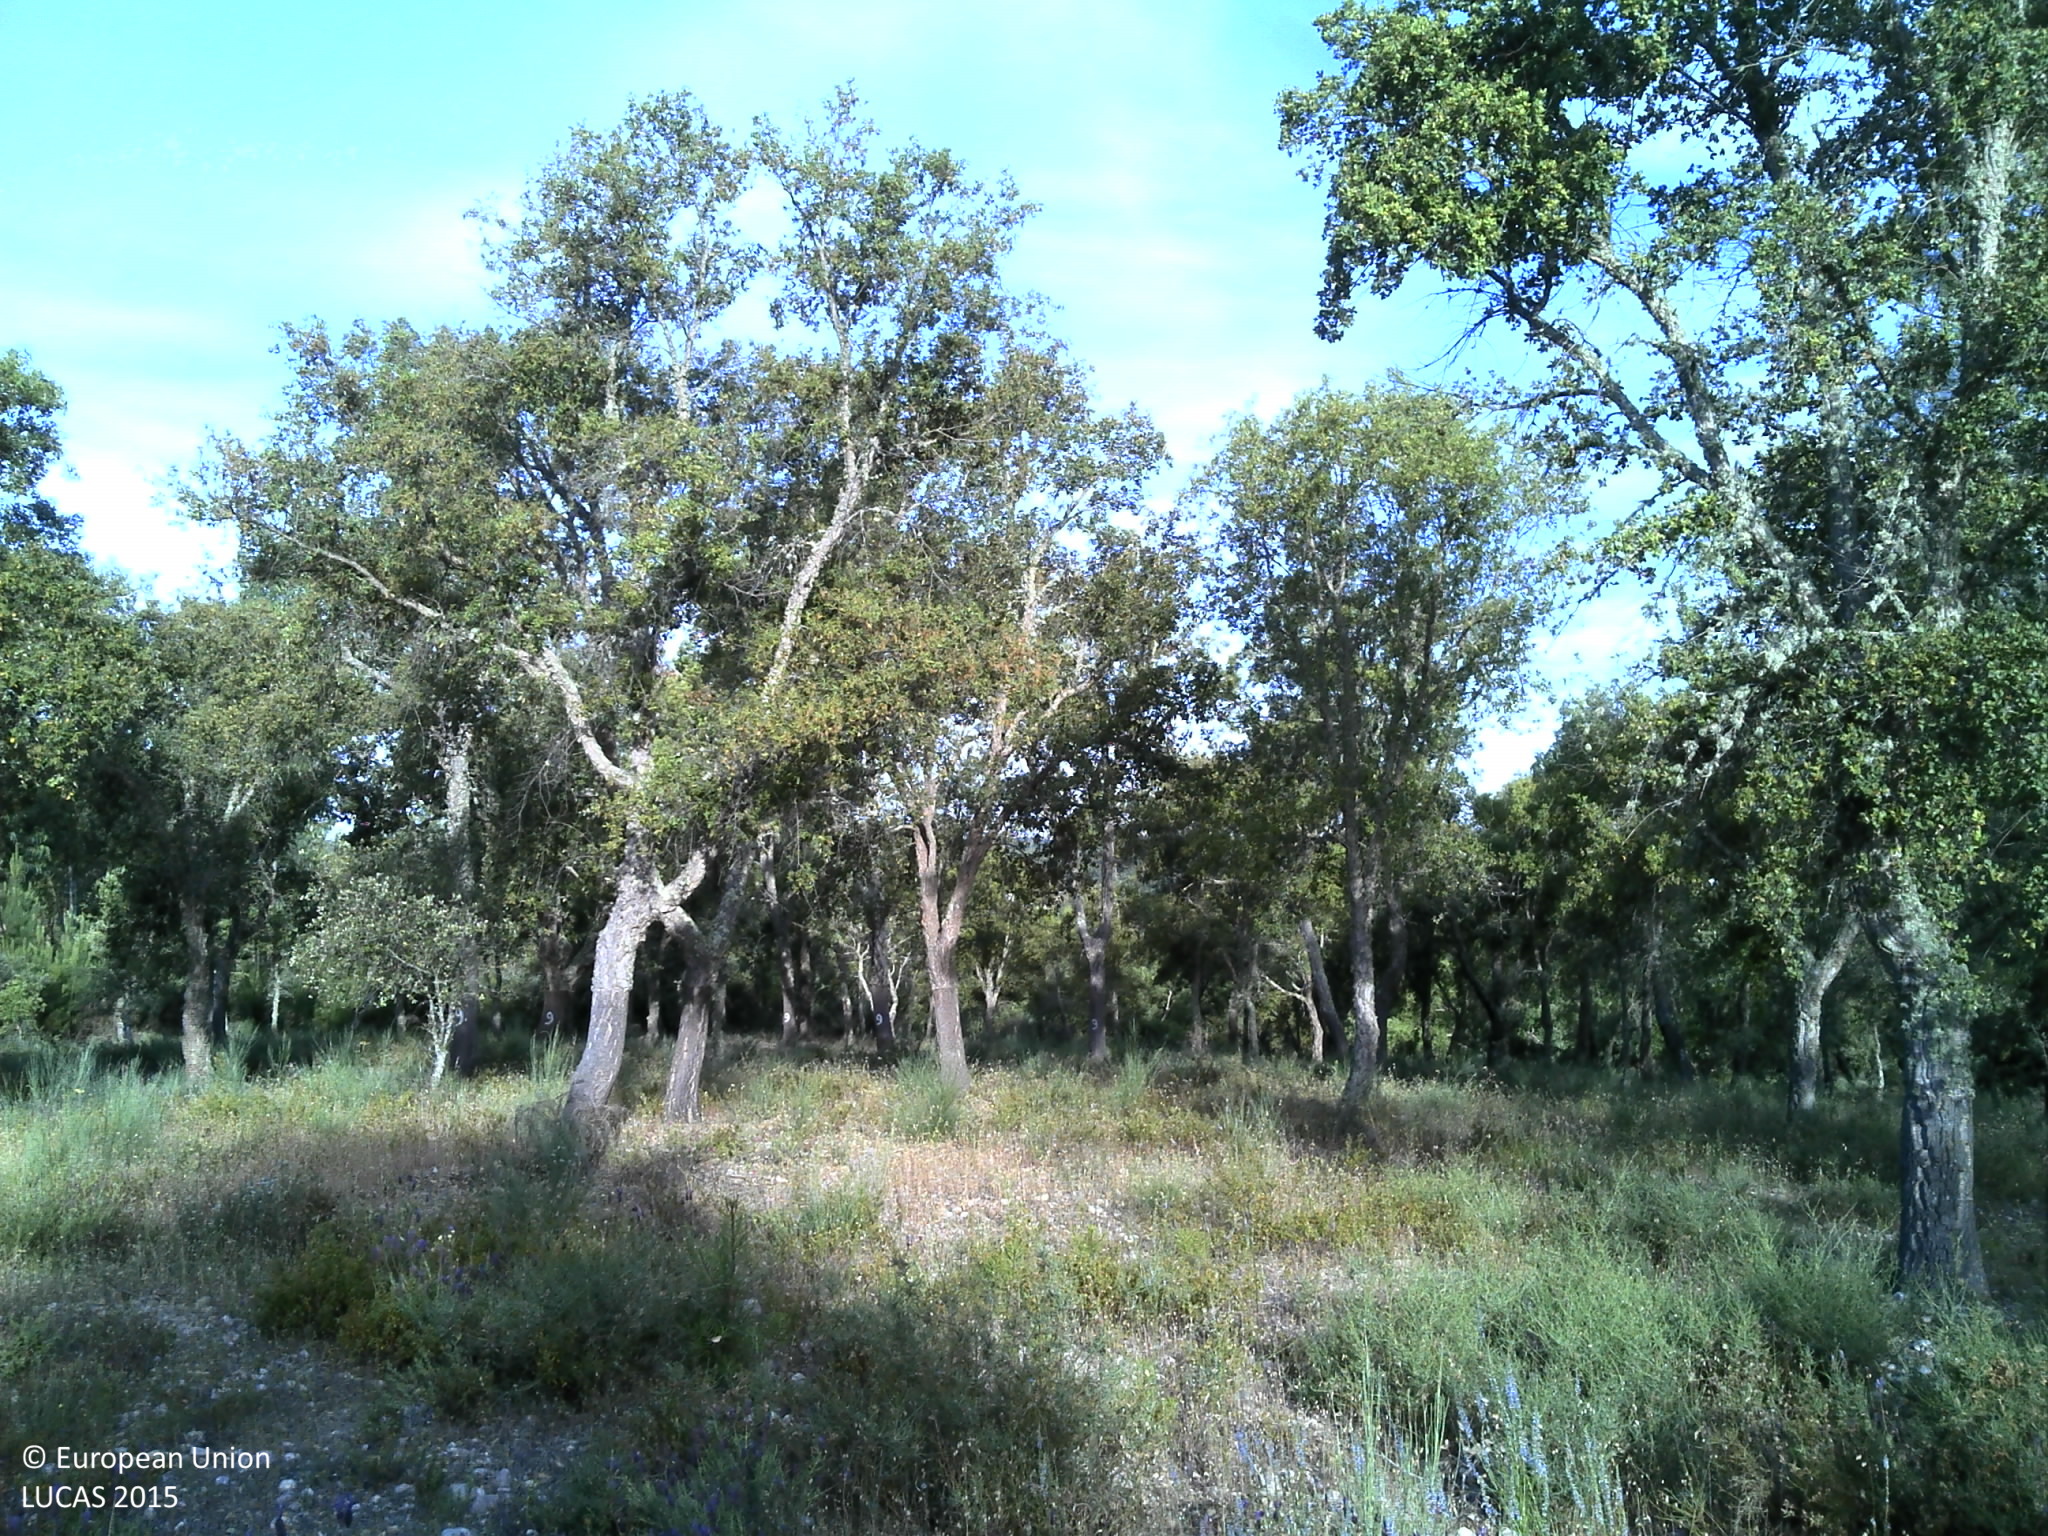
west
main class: Woodland
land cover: Broadleaved woodland
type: broadleaved evergreen forest
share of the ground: 25 - 50 %
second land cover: Shrubland without tree cover
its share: 50 - 75 %
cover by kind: broadleaved forest trees 30 %, shrubs 30 %, herbaceous plants 20 %, unconsolidated bare surface 20 %
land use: Forestry
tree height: > 5 m
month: May
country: PT
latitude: 39.3303
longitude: -7.9788
